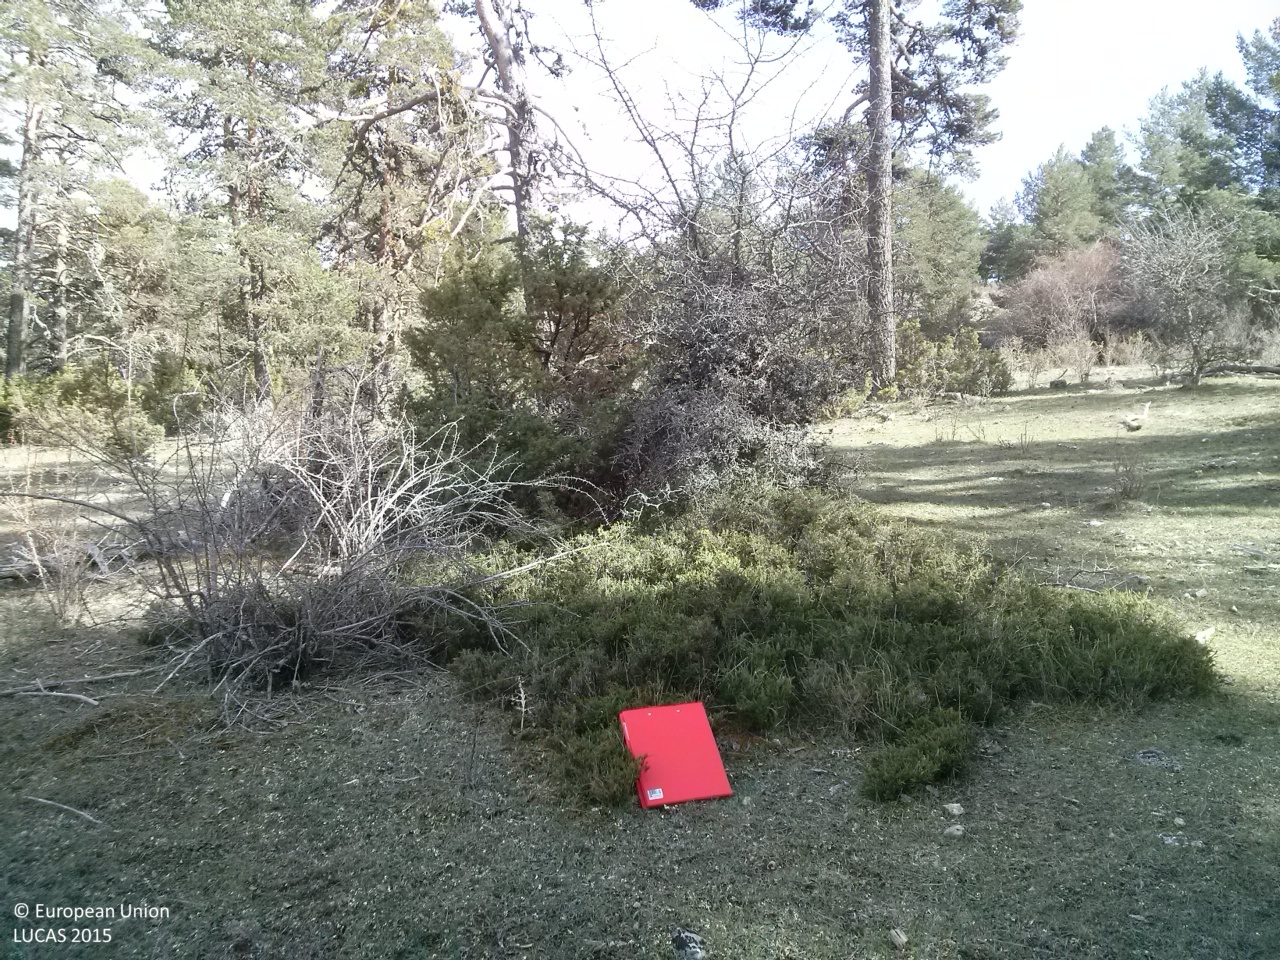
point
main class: Woodland
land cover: Pine dominated coniferous woodland
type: coniferous forest of the mediterranean region
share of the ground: 10 - 25 %
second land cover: Grassland without tree/shrub cover
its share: > 75 %
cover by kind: herbaceous plants 70 %, coniferous forest trees 20 %, shrubs 10 %
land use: Forestry
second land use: Agriculture (excluding fallow land and kitchen gardens)
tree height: > 5 m
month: April
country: ES
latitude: 40.3089
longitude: -1.8887
